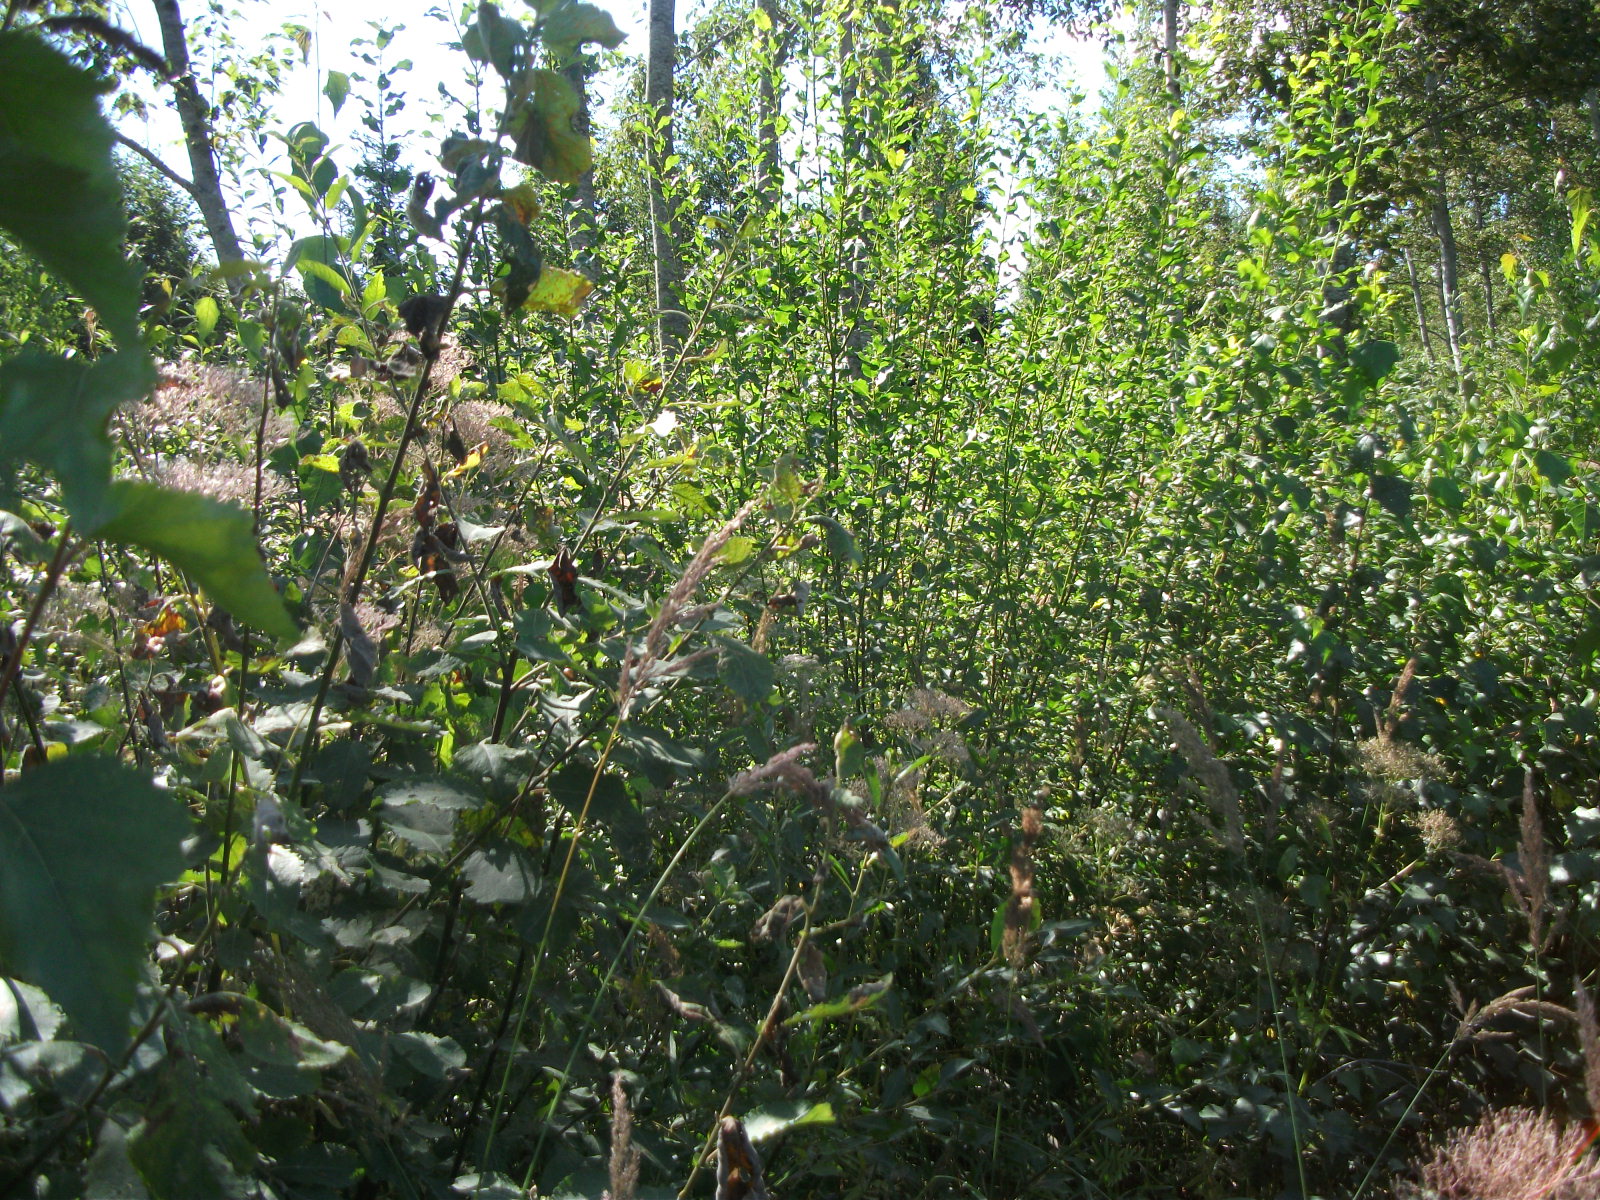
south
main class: Woodland
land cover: Broadleaved woodland
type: non-riverine alder, birch or aspen forest
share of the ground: 50 - 75 %
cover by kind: broadleaved forest trees 50 %, shrubs 30 %, herbaceous plants 20 %
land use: Semi-natural and natural areas not in use
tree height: > 5 m
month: August
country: LV
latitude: 56.6122
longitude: 26.2545
